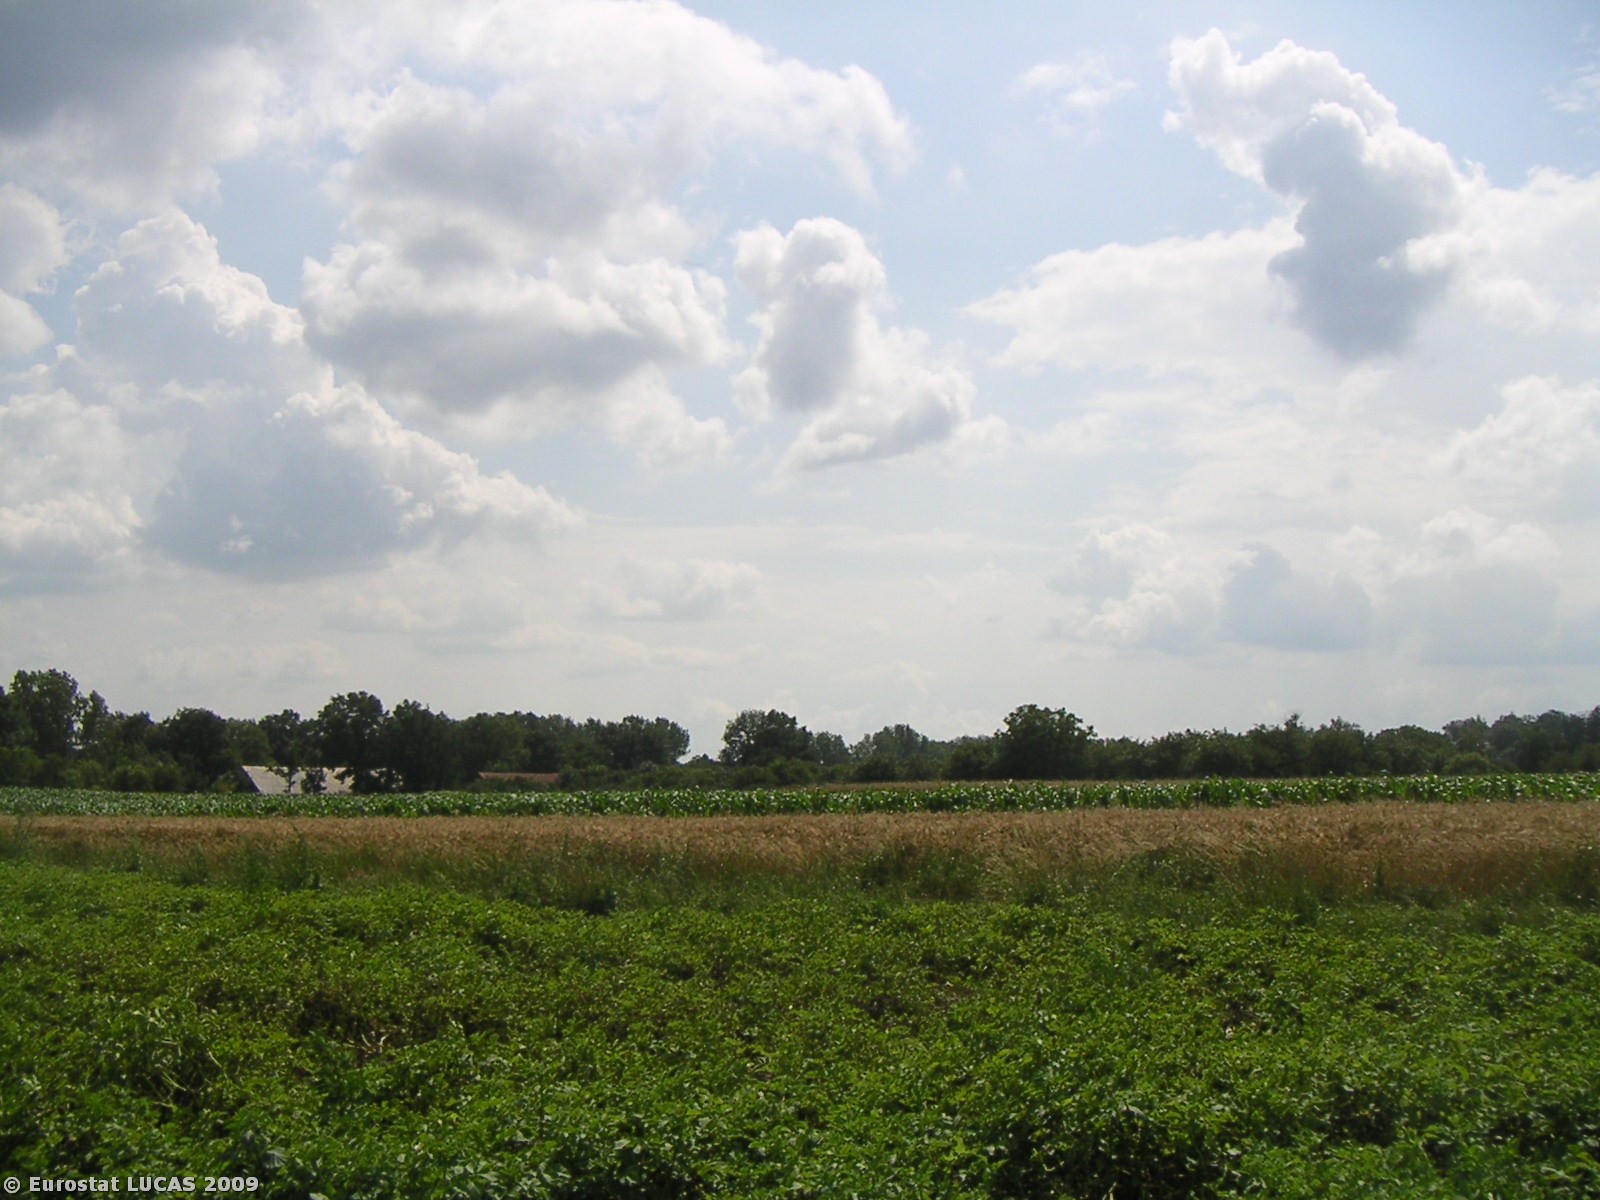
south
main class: Cropland
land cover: Potatoes
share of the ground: > 75 %
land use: Agriculture (excluding fallow land and kitchen gardens)
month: July
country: PL
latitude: 50.4835
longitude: 19.8257
